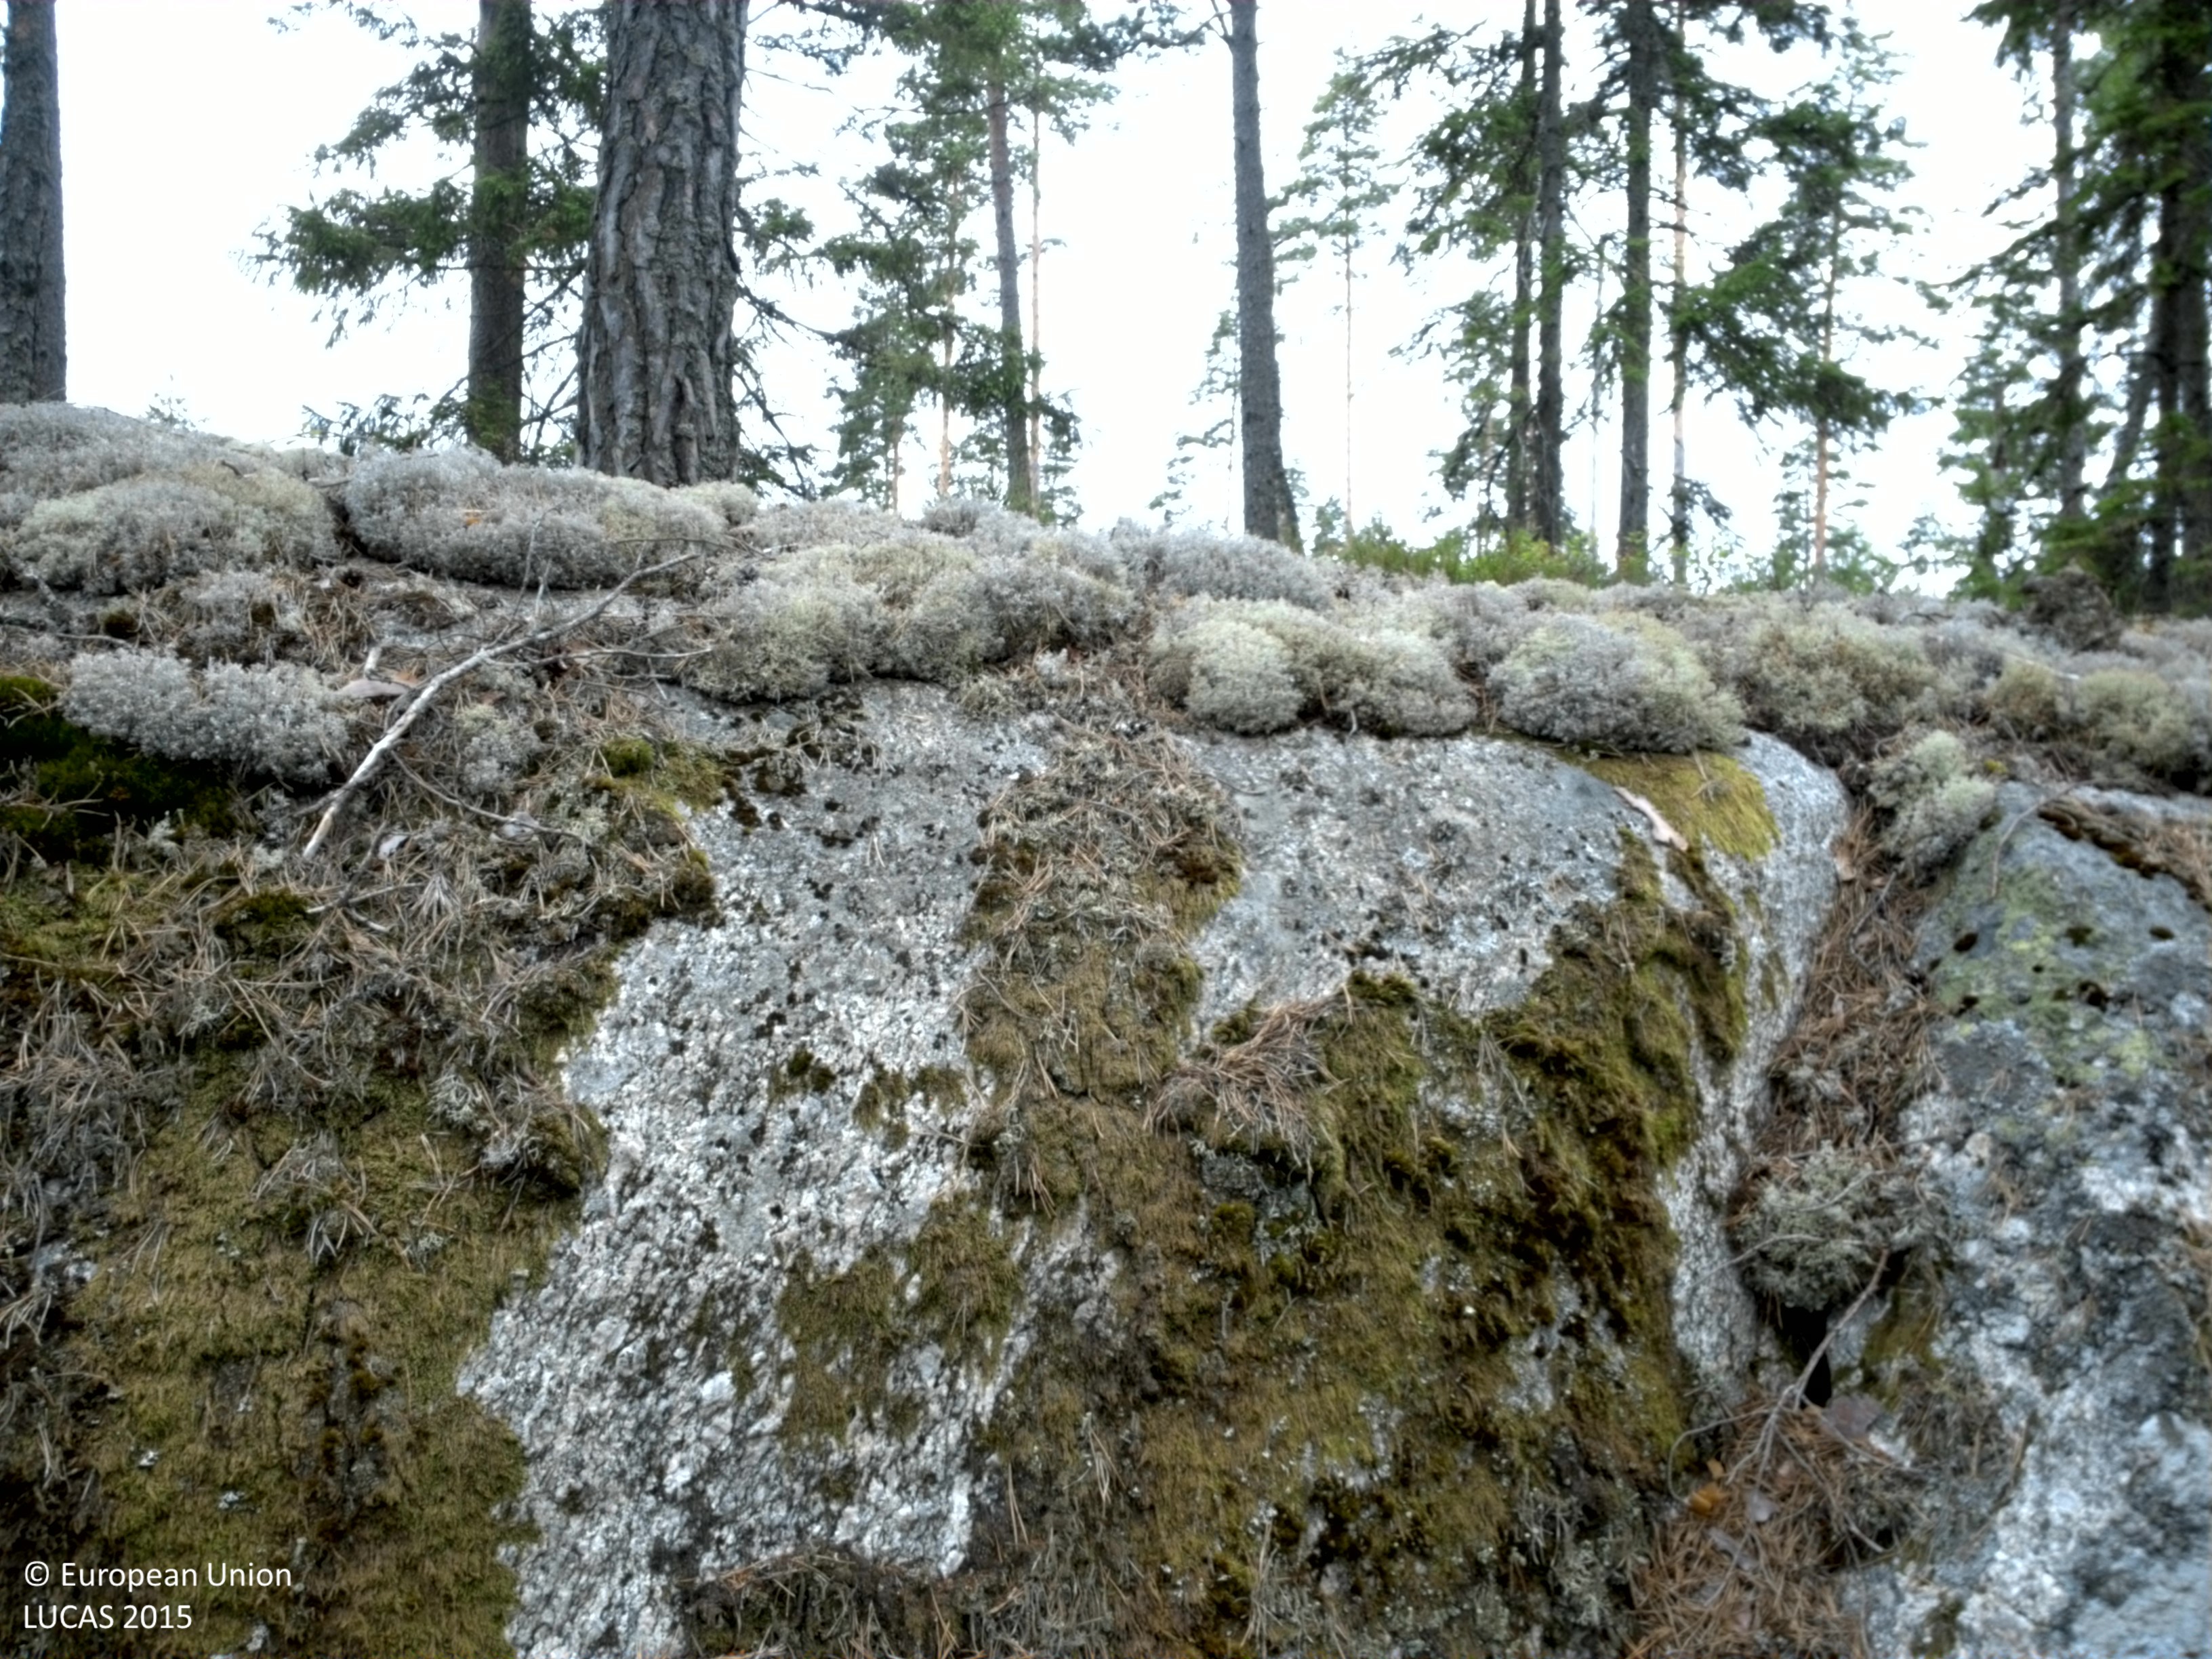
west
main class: Woodland
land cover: Pine dominated coniferous woodland
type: boreal forest
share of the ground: 10 - 25 %
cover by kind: herbaceous plants 50 %, lichens and mosses 30 %, coniferous forest trees 20 %
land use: Forestry
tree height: > 5 m
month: July
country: SE
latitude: 58.7794
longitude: 15.3725
